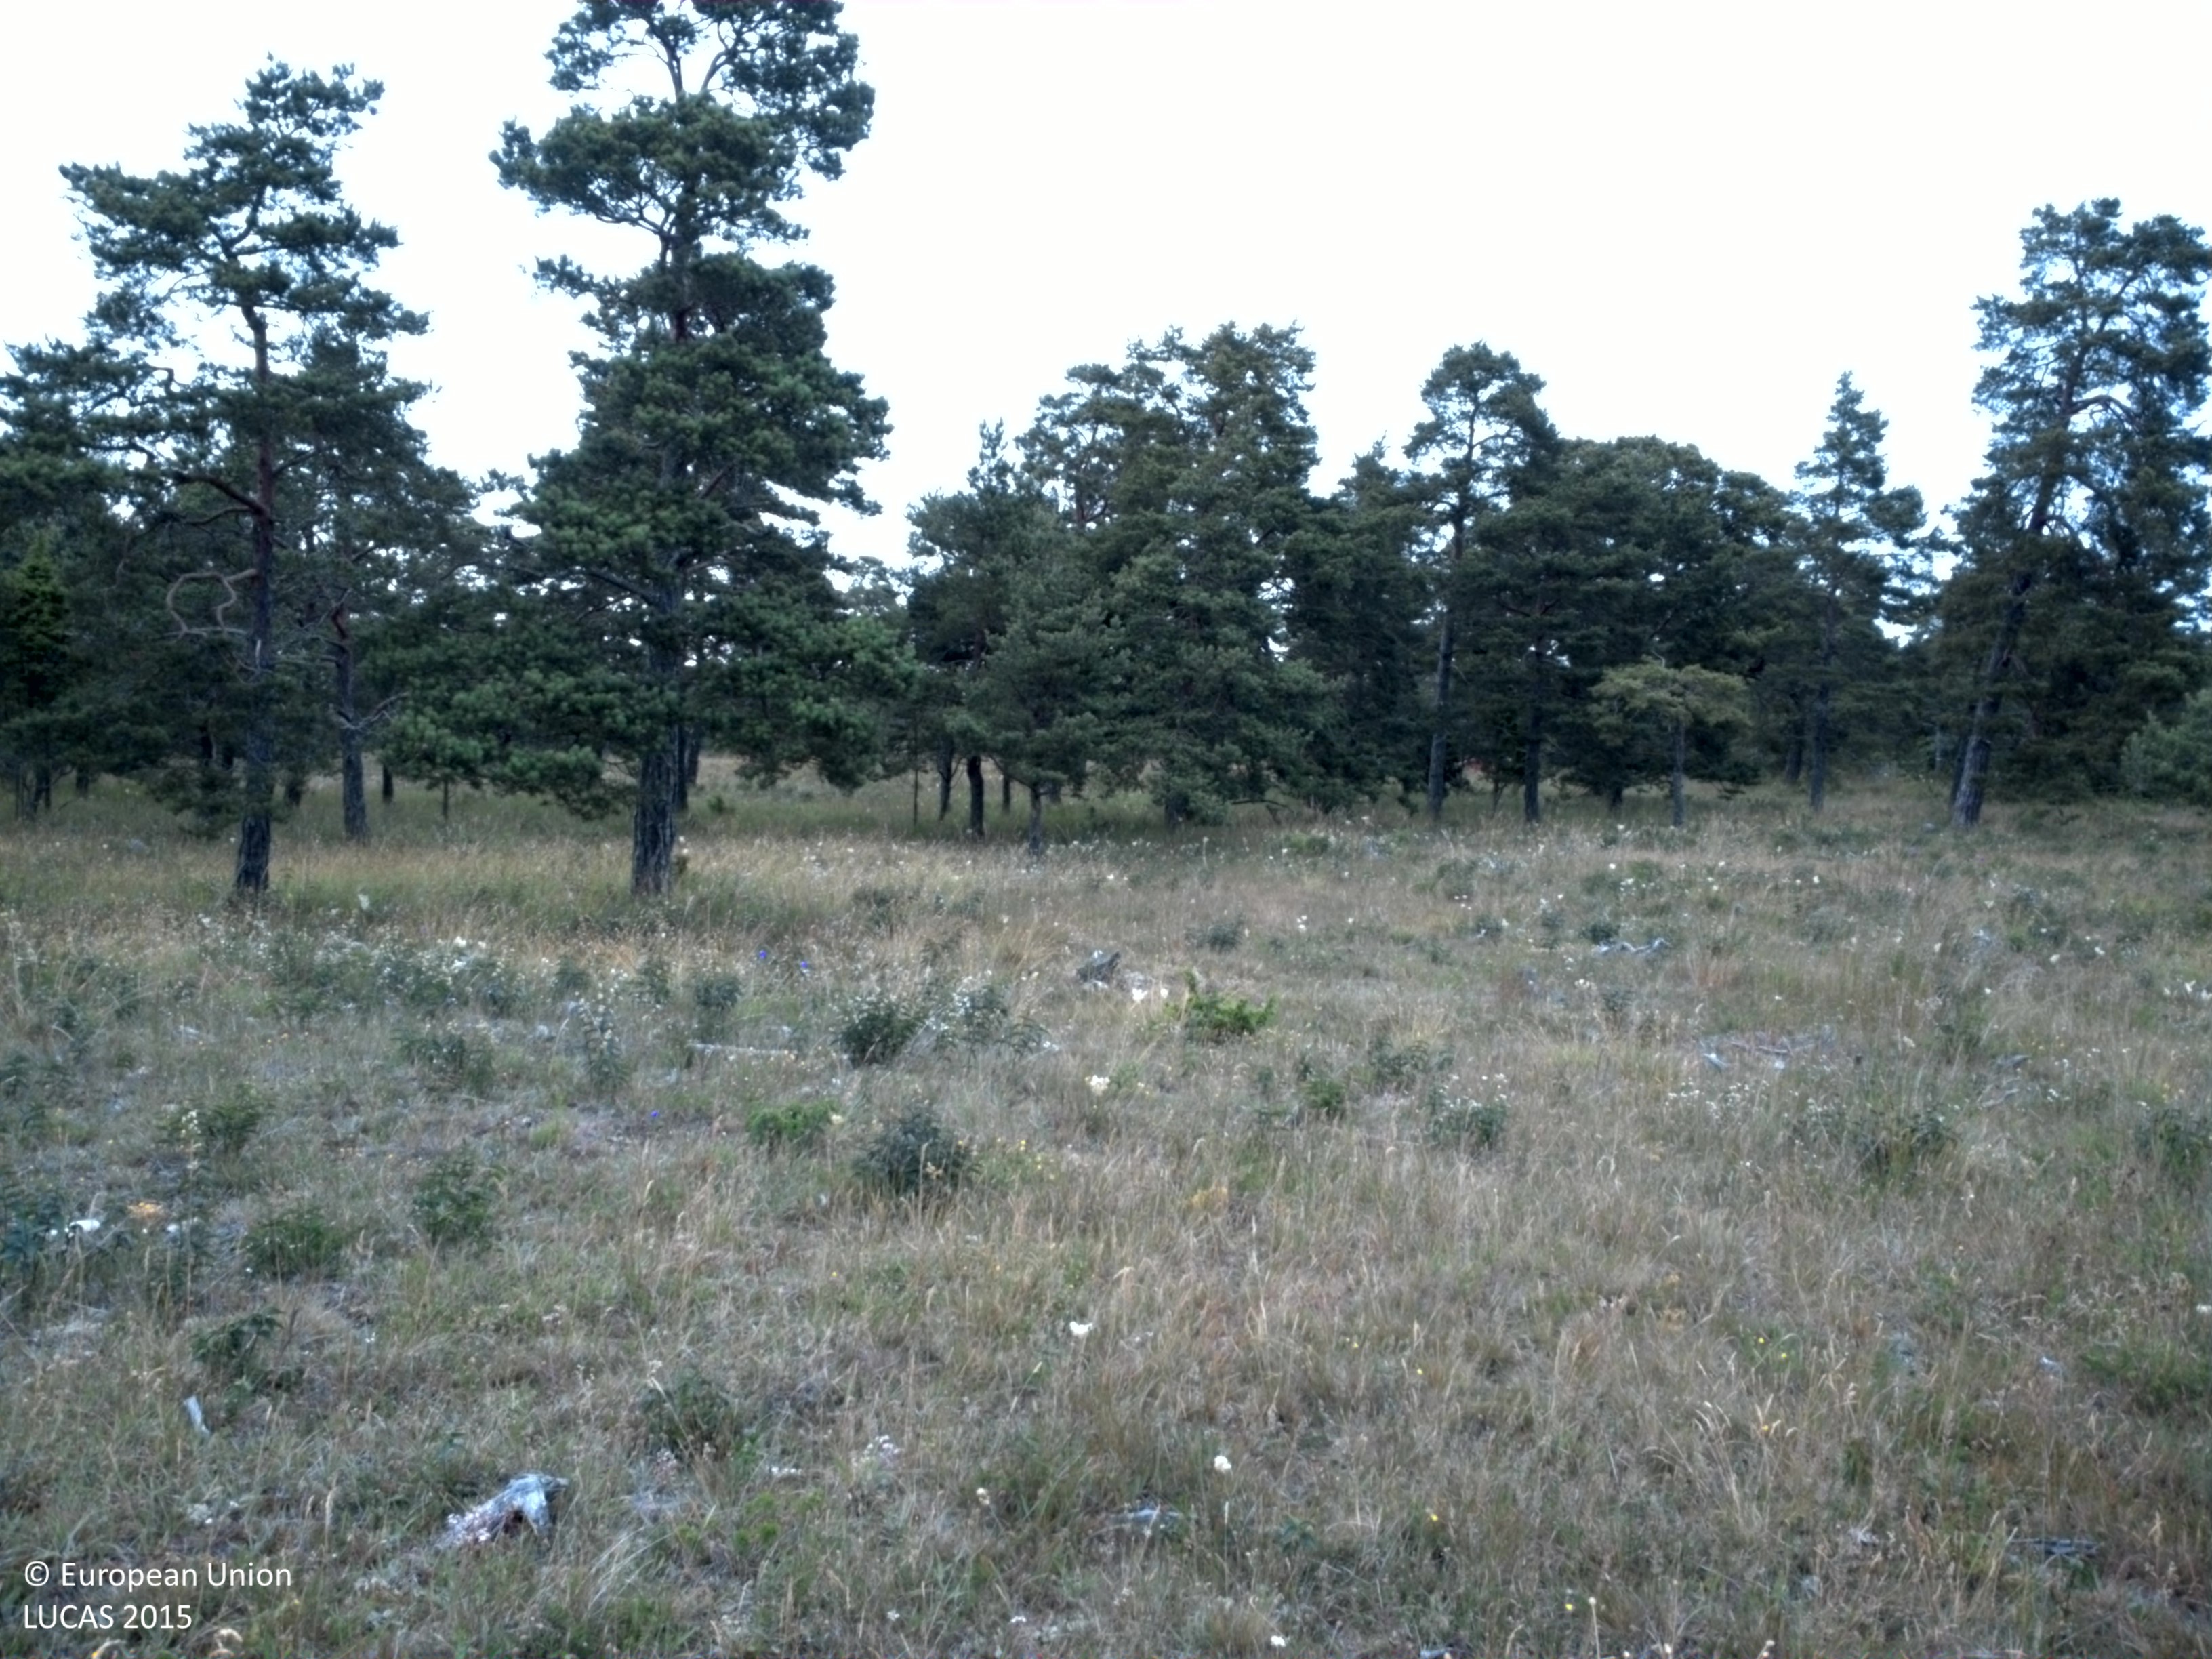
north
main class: Grassland
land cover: Grassland with sparse tree/shrub cover
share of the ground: > 75 %
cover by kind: herbaceous plants 85 %, coniferous forest trees 5 %, shrubs 5 %, lichens and mosses 5 %
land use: Agriculture (excluding fallow land and kitchen gardens)
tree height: > 5 m
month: June
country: SE
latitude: 57.9056
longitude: 18.9029
